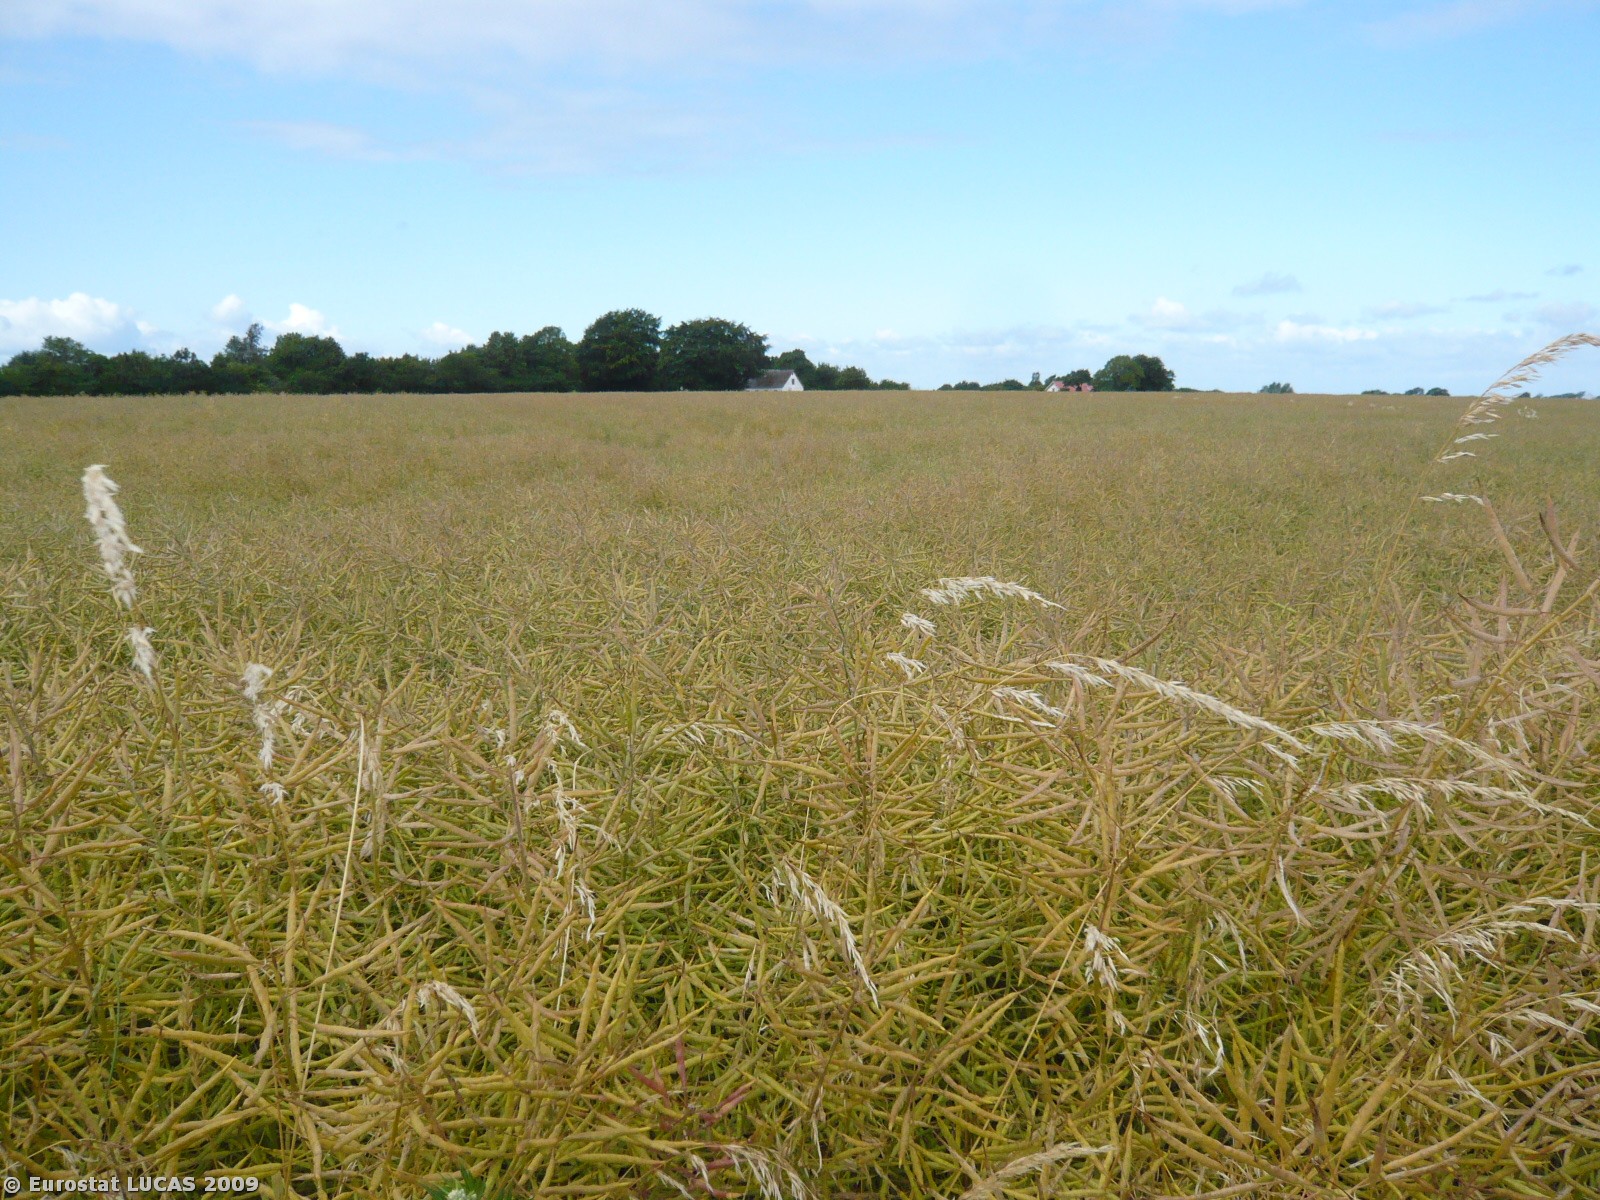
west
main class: Cropland
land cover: Rape and turnip rape
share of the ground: > 75 %
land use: Agriculture (excluding fallow land and kitchen gardens)
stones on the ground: < 10 %
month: July
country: DK
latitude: 55.5162
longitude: 11.2816
